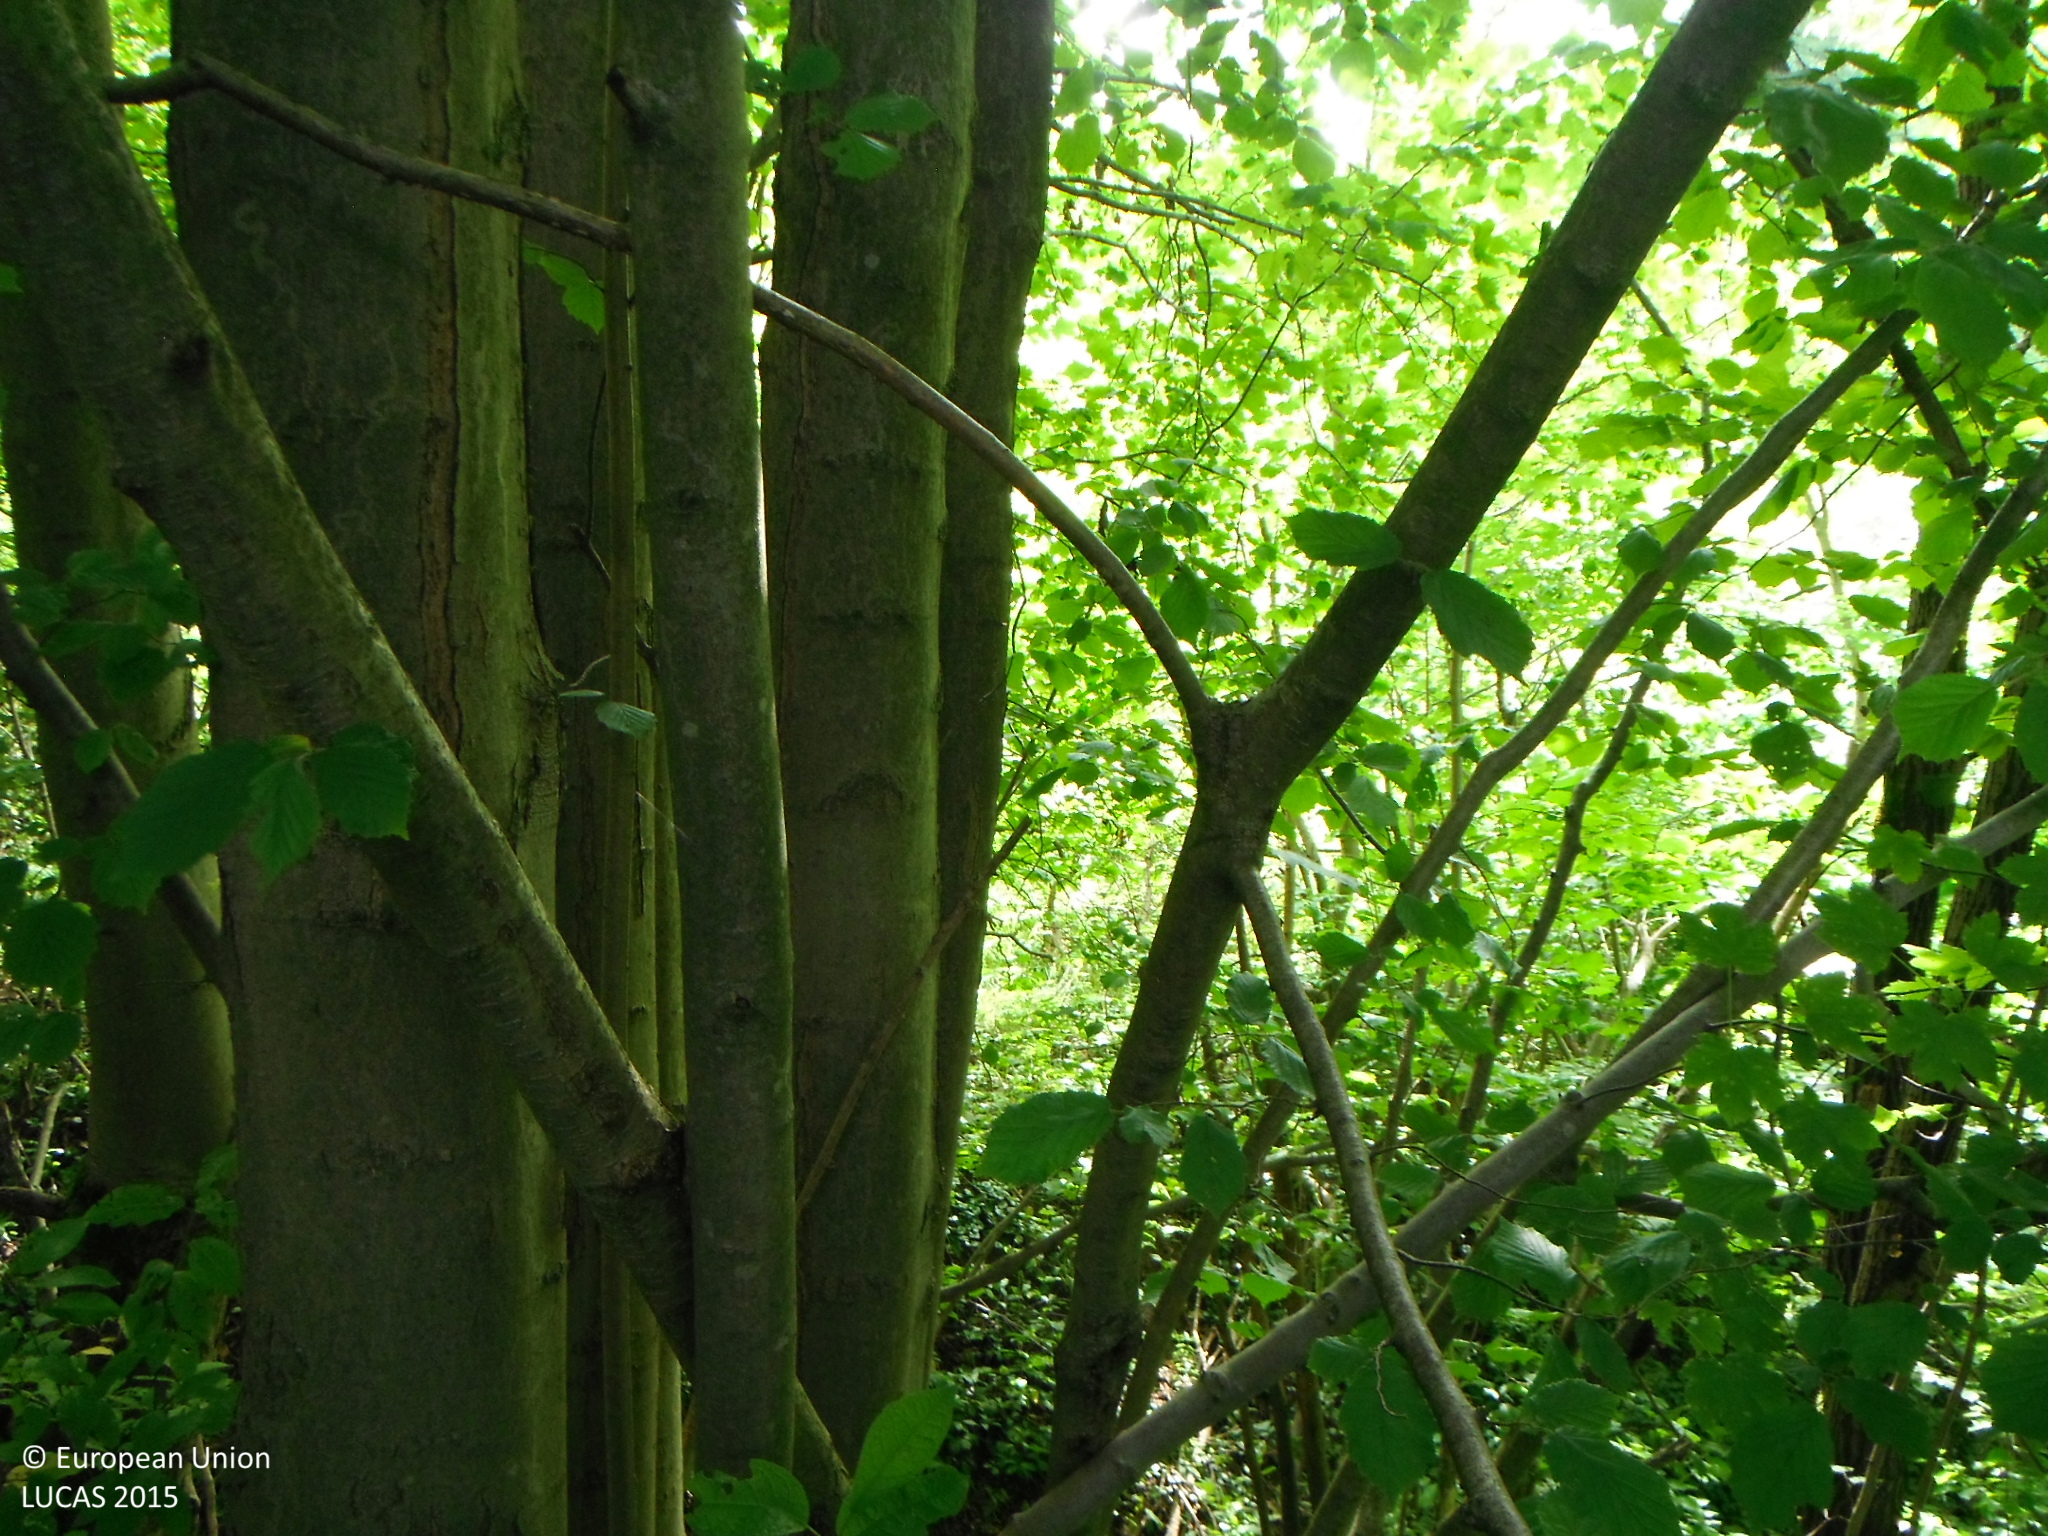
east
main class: Woodland
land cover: Broadleaved woodland
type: mesophytic deciduous forest
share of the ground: > 75 %
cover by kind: broadleaved forest trees 100 %
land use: Semi-natural and natural areas not in use
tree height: > 5 m
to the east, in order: Broadleaved woodland; Rivers and streams; Broadleaved woodland; Grassland without tree/shrub cover; Grassland with sparse tree/shrub cover; Grassland without tree/shrub cover; Shrubland with sparse tree cover; Grassland with sparse tree/shrub cover; Broadleaved woodland; Grassland without tree/shrub cover
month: July
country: SK
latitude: 49.2939
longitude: 19.1118
